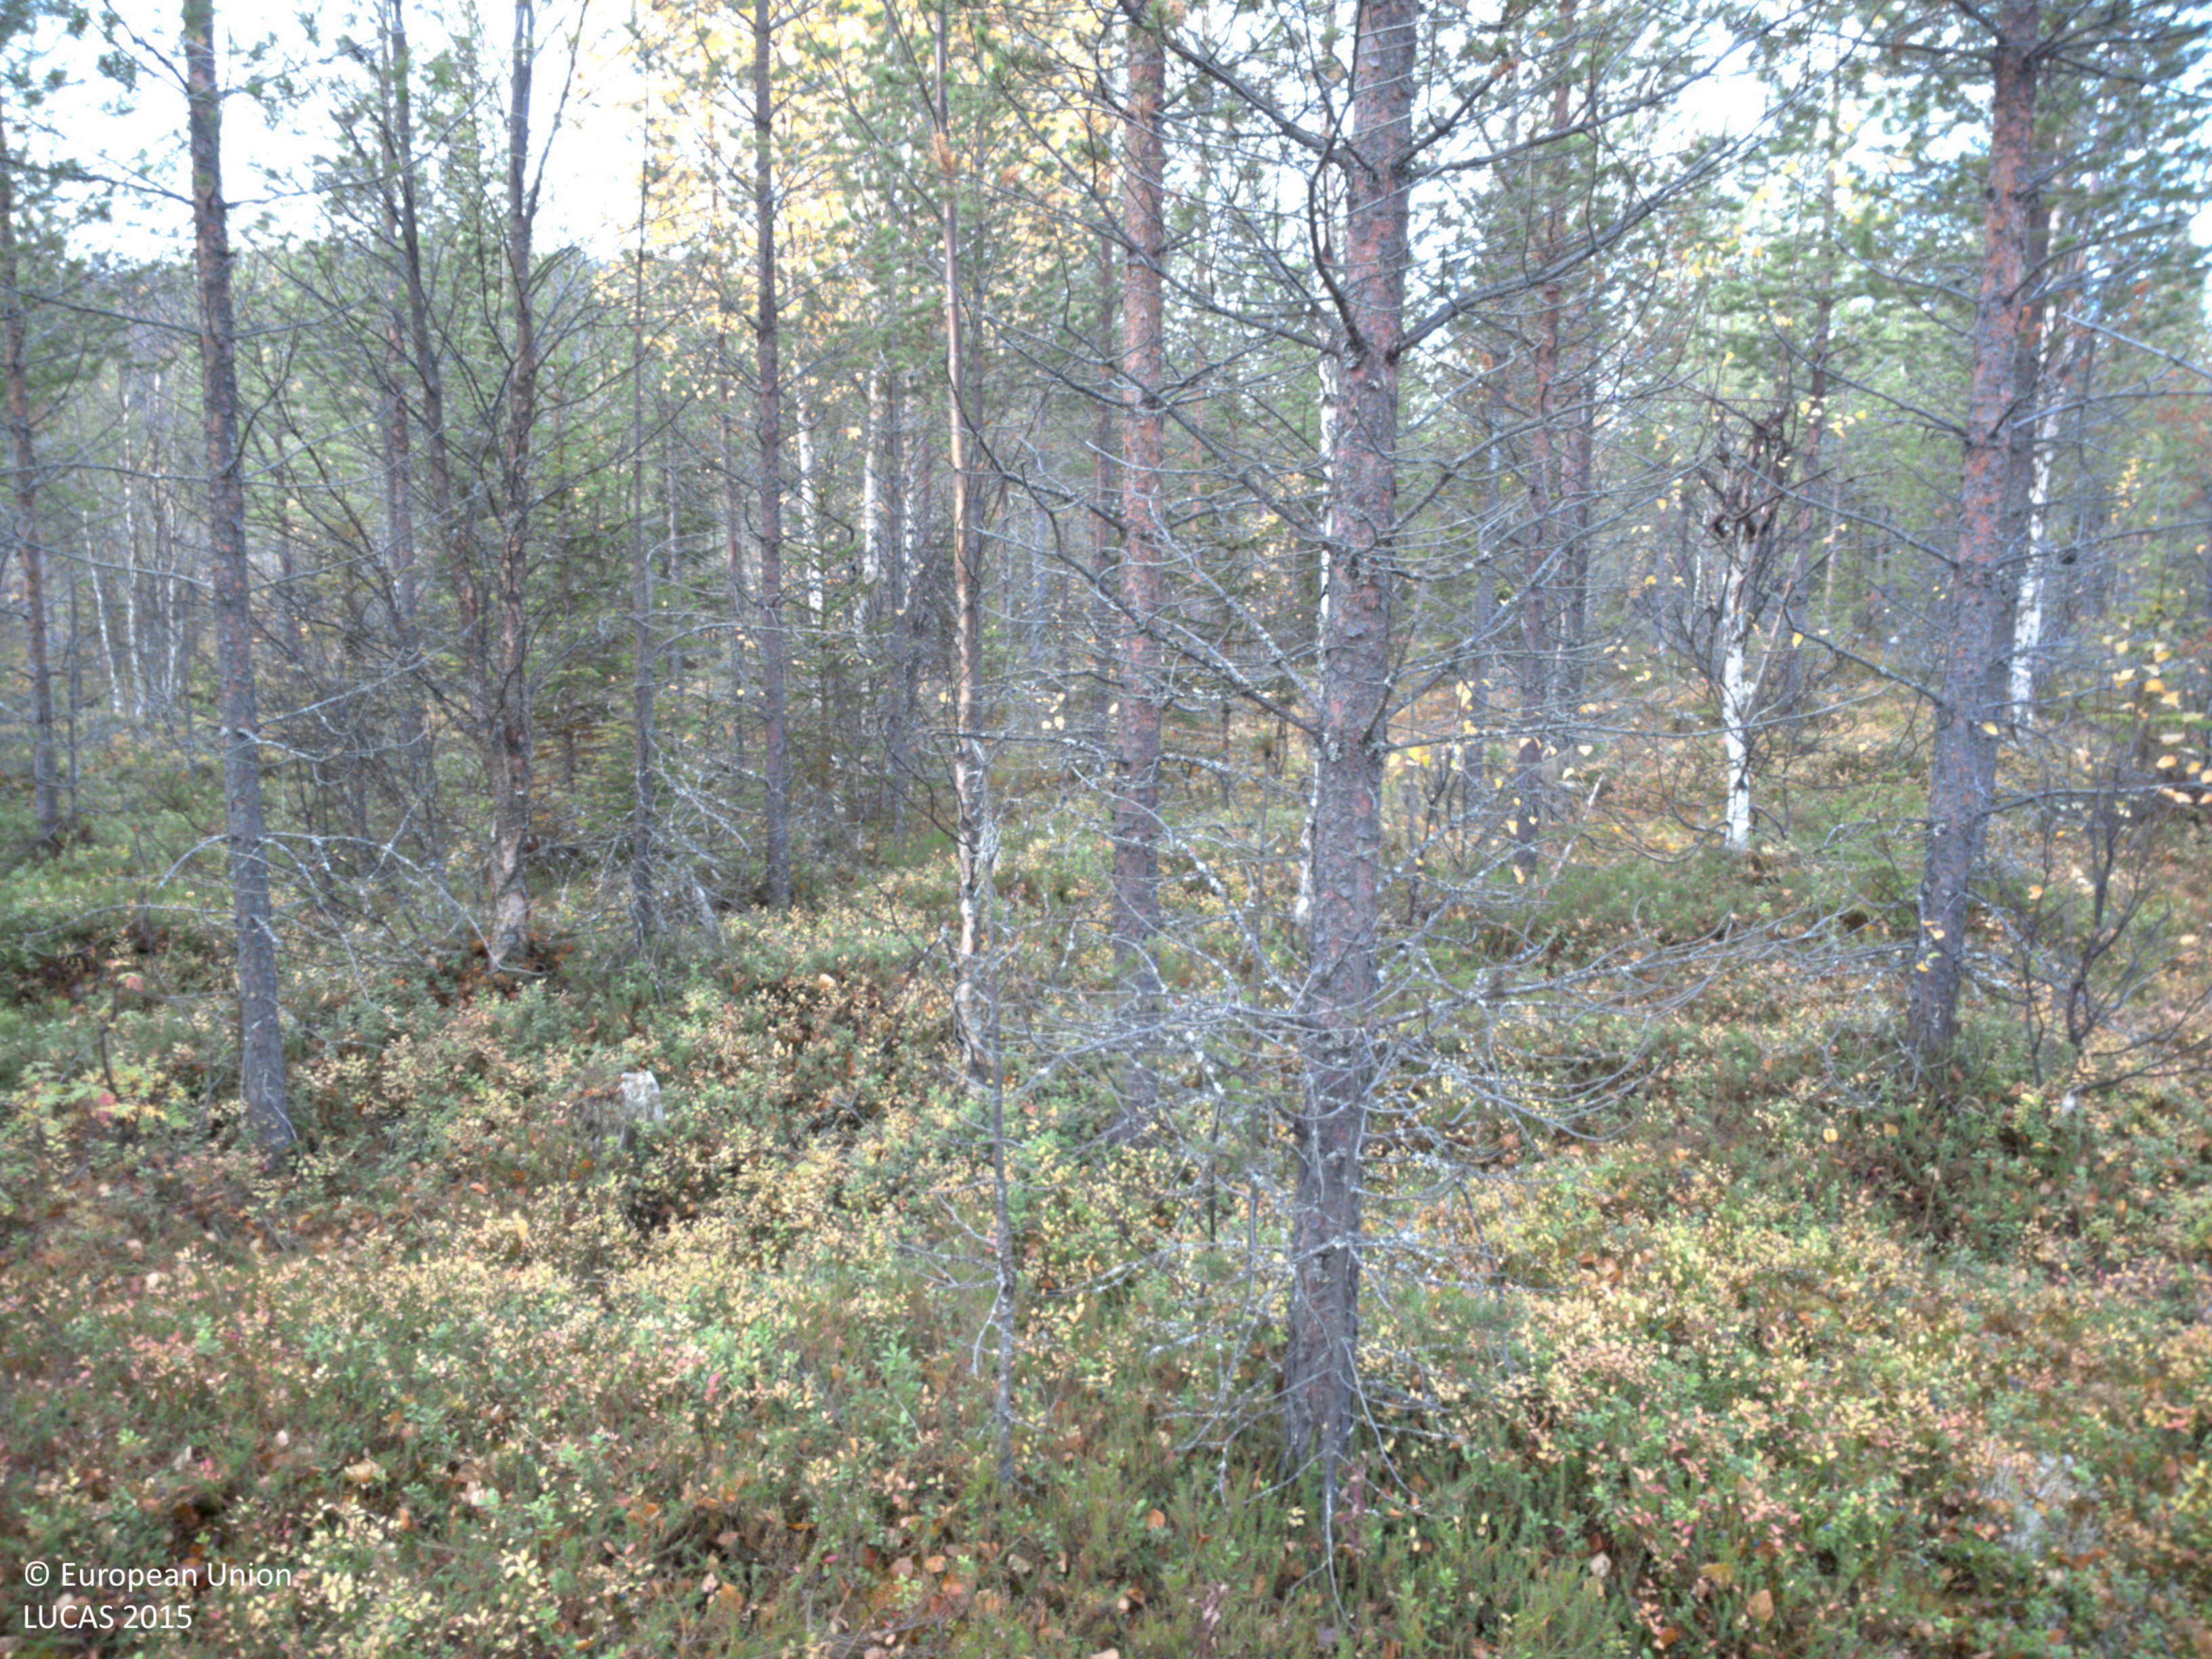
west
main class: Woodland
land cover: Pine dominated coniferous woodland
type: boreal forest
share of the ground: 50 - 75 %
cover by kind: coniferous forest trees 65 %, shrubs 20 %, broadleaved forest trees 5 %, herbaceous plants 5 %, lichens and mosses 5 %
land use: Forestry
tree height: < 5 m
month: October
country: SE
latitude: 64.6787
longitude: 18.1599
